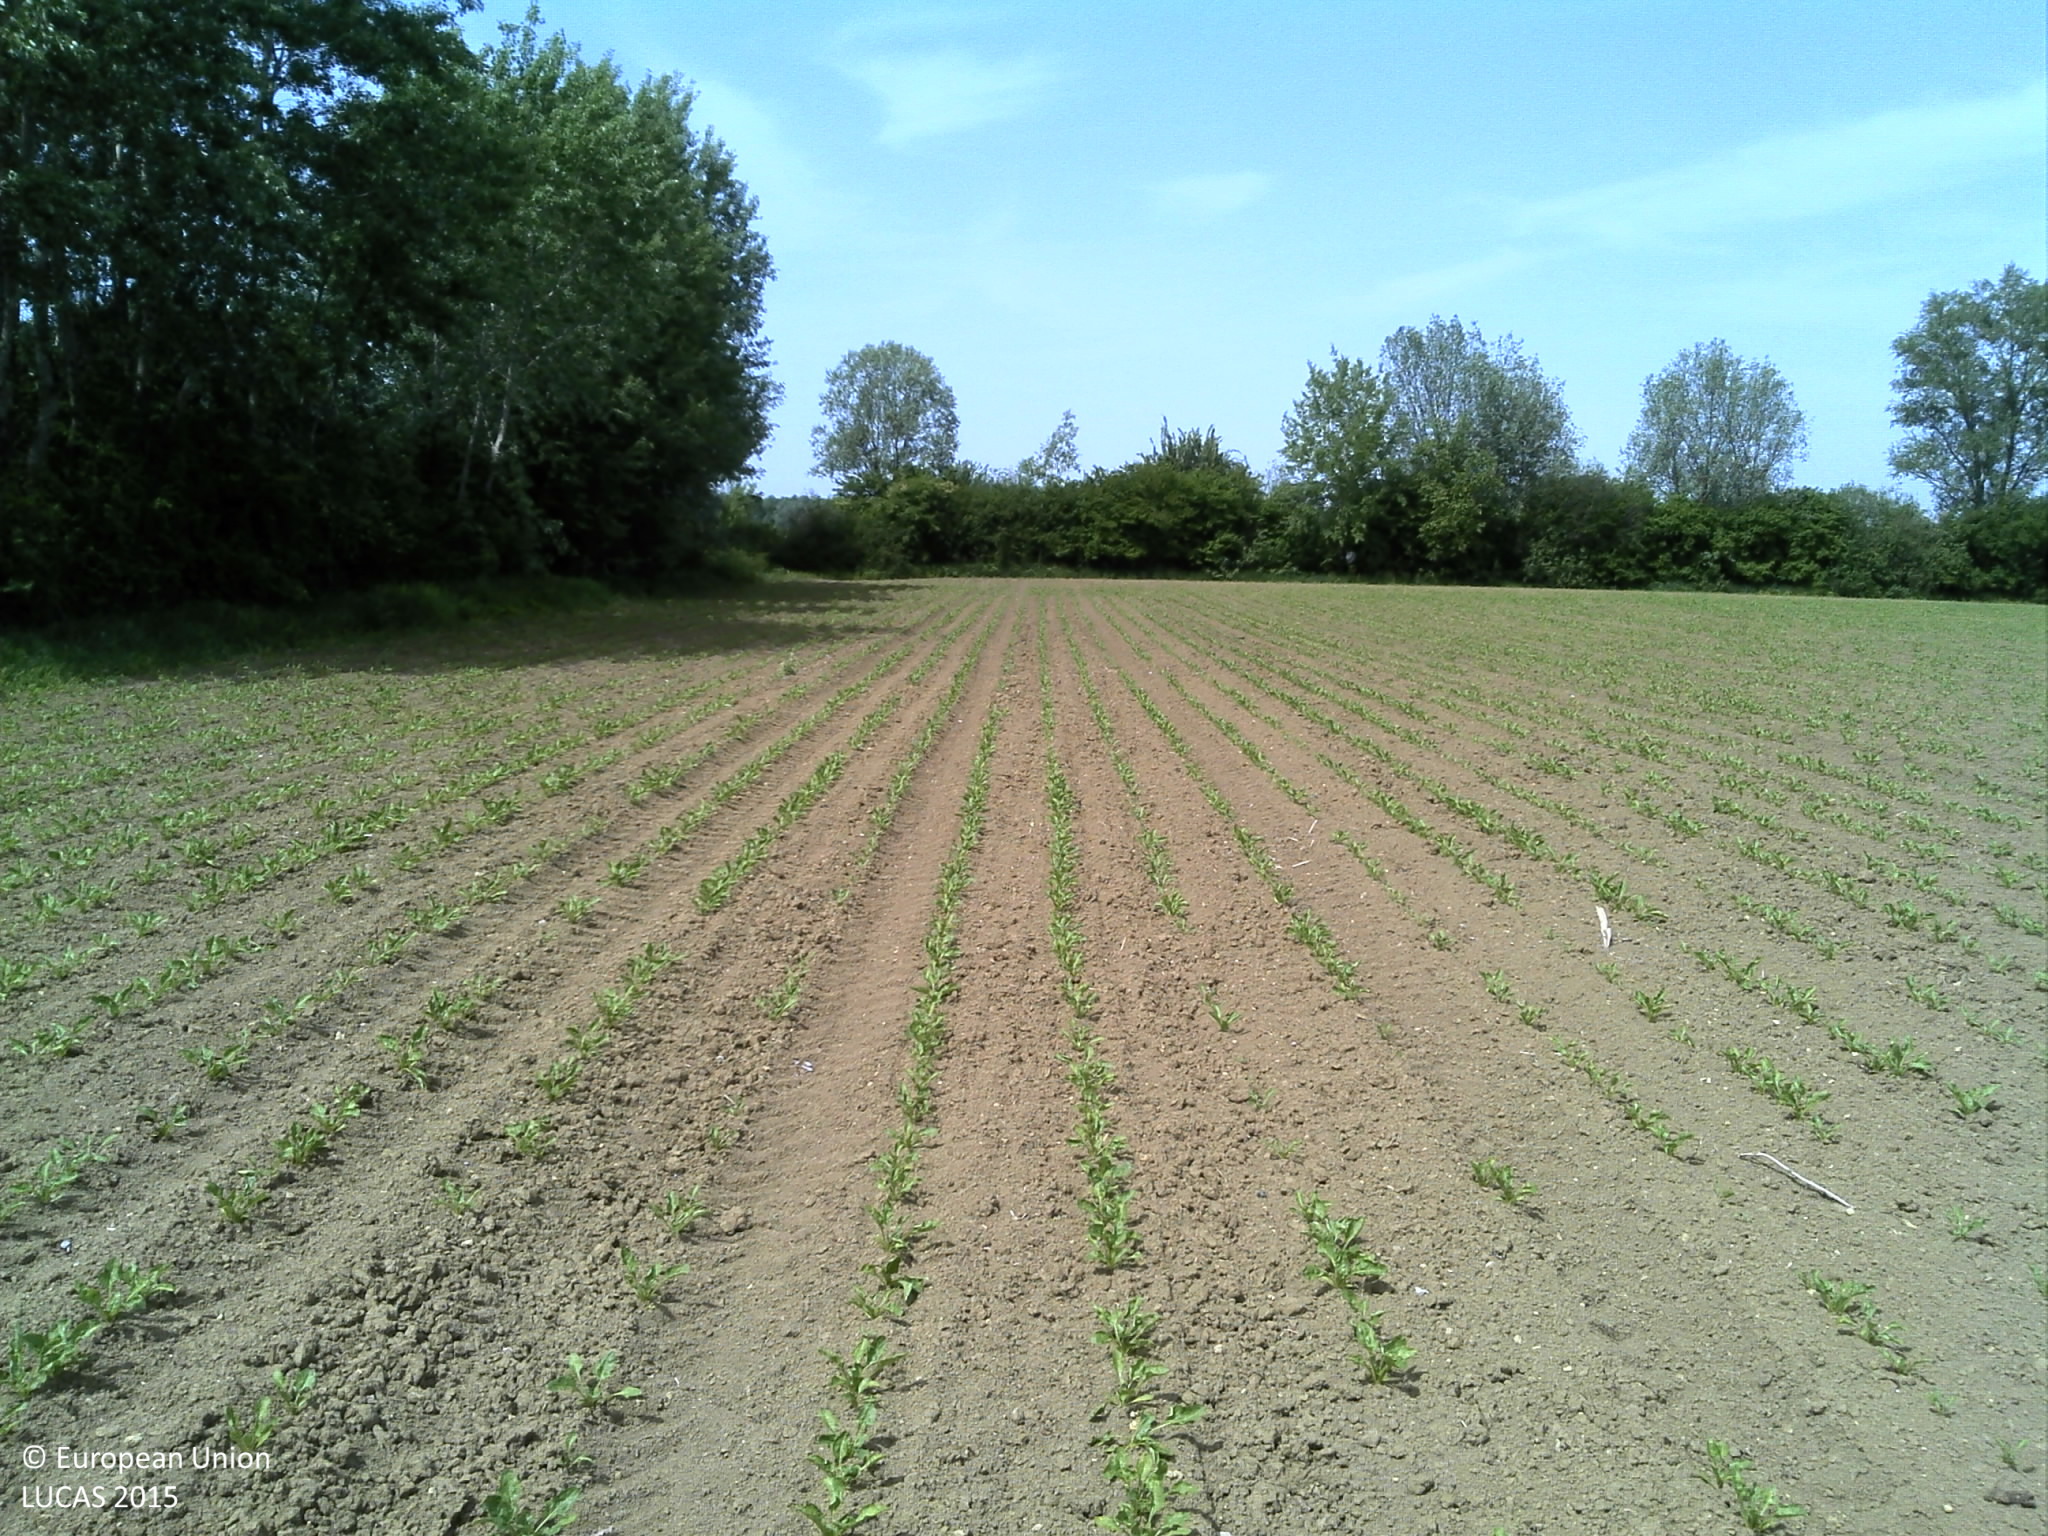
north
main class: Cropland
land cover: Sugar beet
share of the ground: < 10 %
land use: Agriculture (excluding fallow land and kitchen gardens)
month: May
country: HR
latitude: 45.1977
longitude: 18.4958
